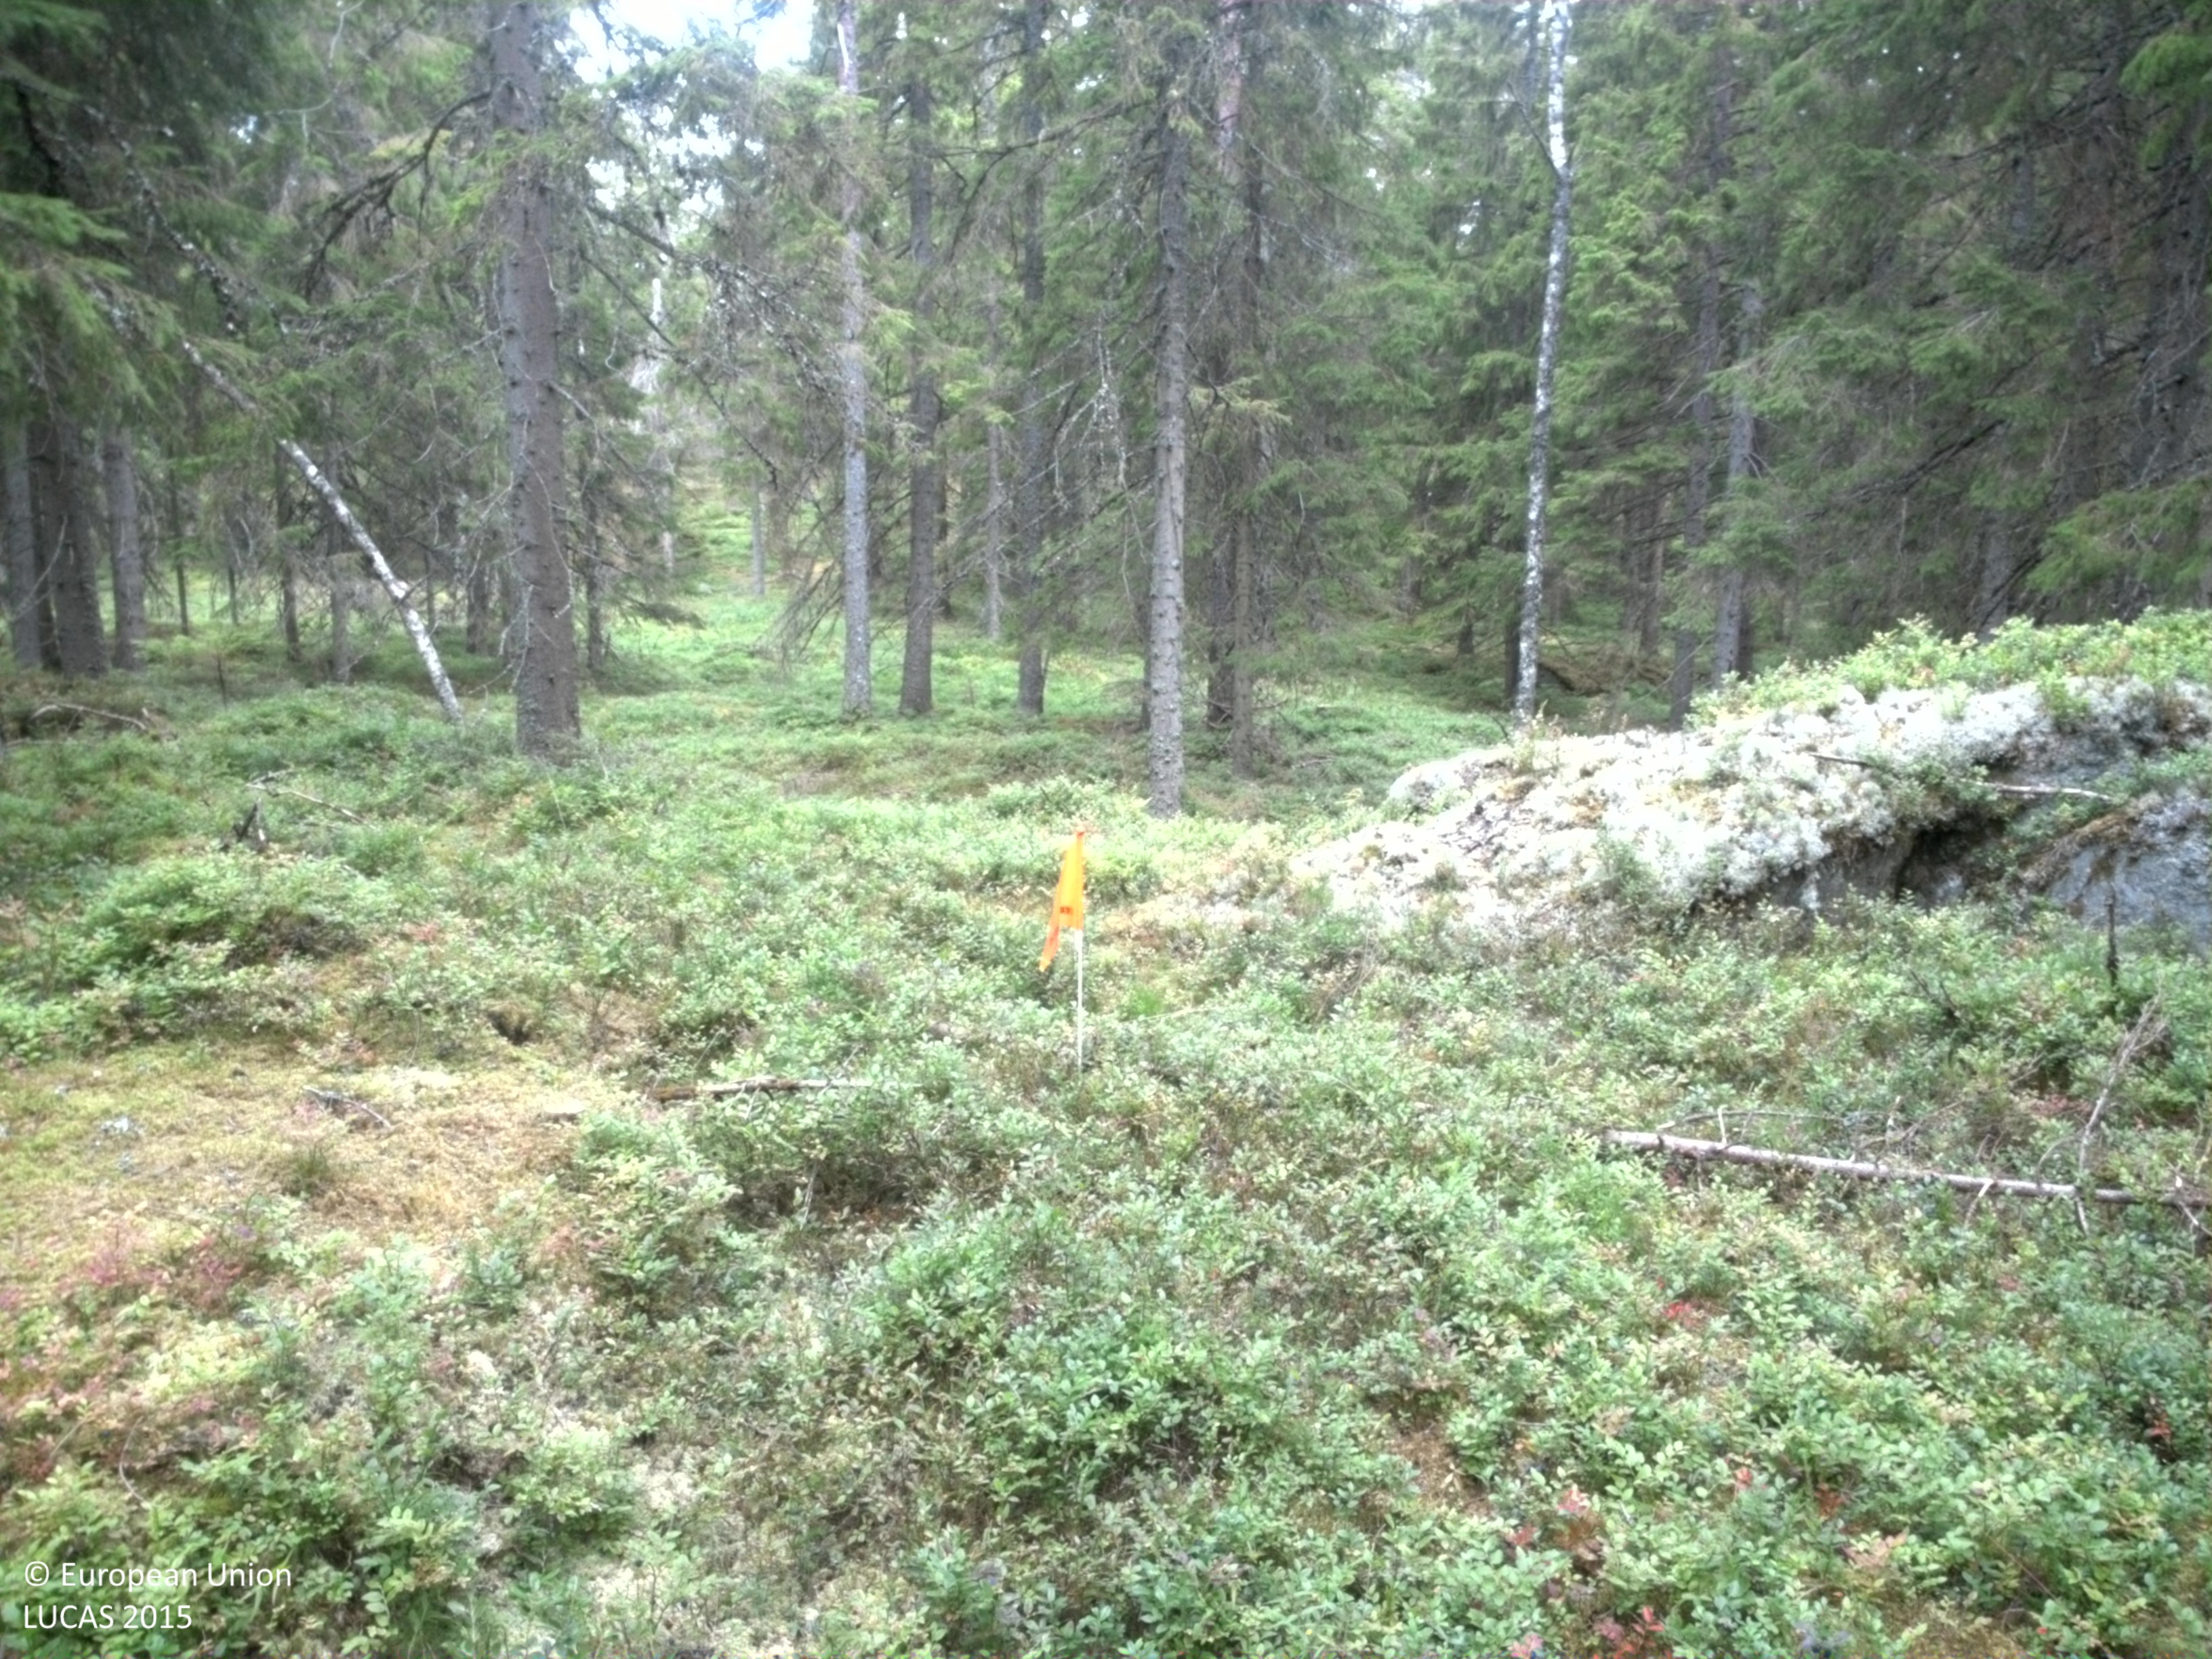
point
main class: Woodland
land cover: Spruce dominated coniferous woodland
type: boreal forest
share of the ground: 50 - 75 %
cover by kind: coniferous forest trees 55 %, shrubs 30 %, lichens and mosses 15 %
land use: Forestry
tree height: > 5 m
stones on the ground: 10 - 25 %
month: August
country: SE
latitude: 57.9829
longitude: 13.9011
